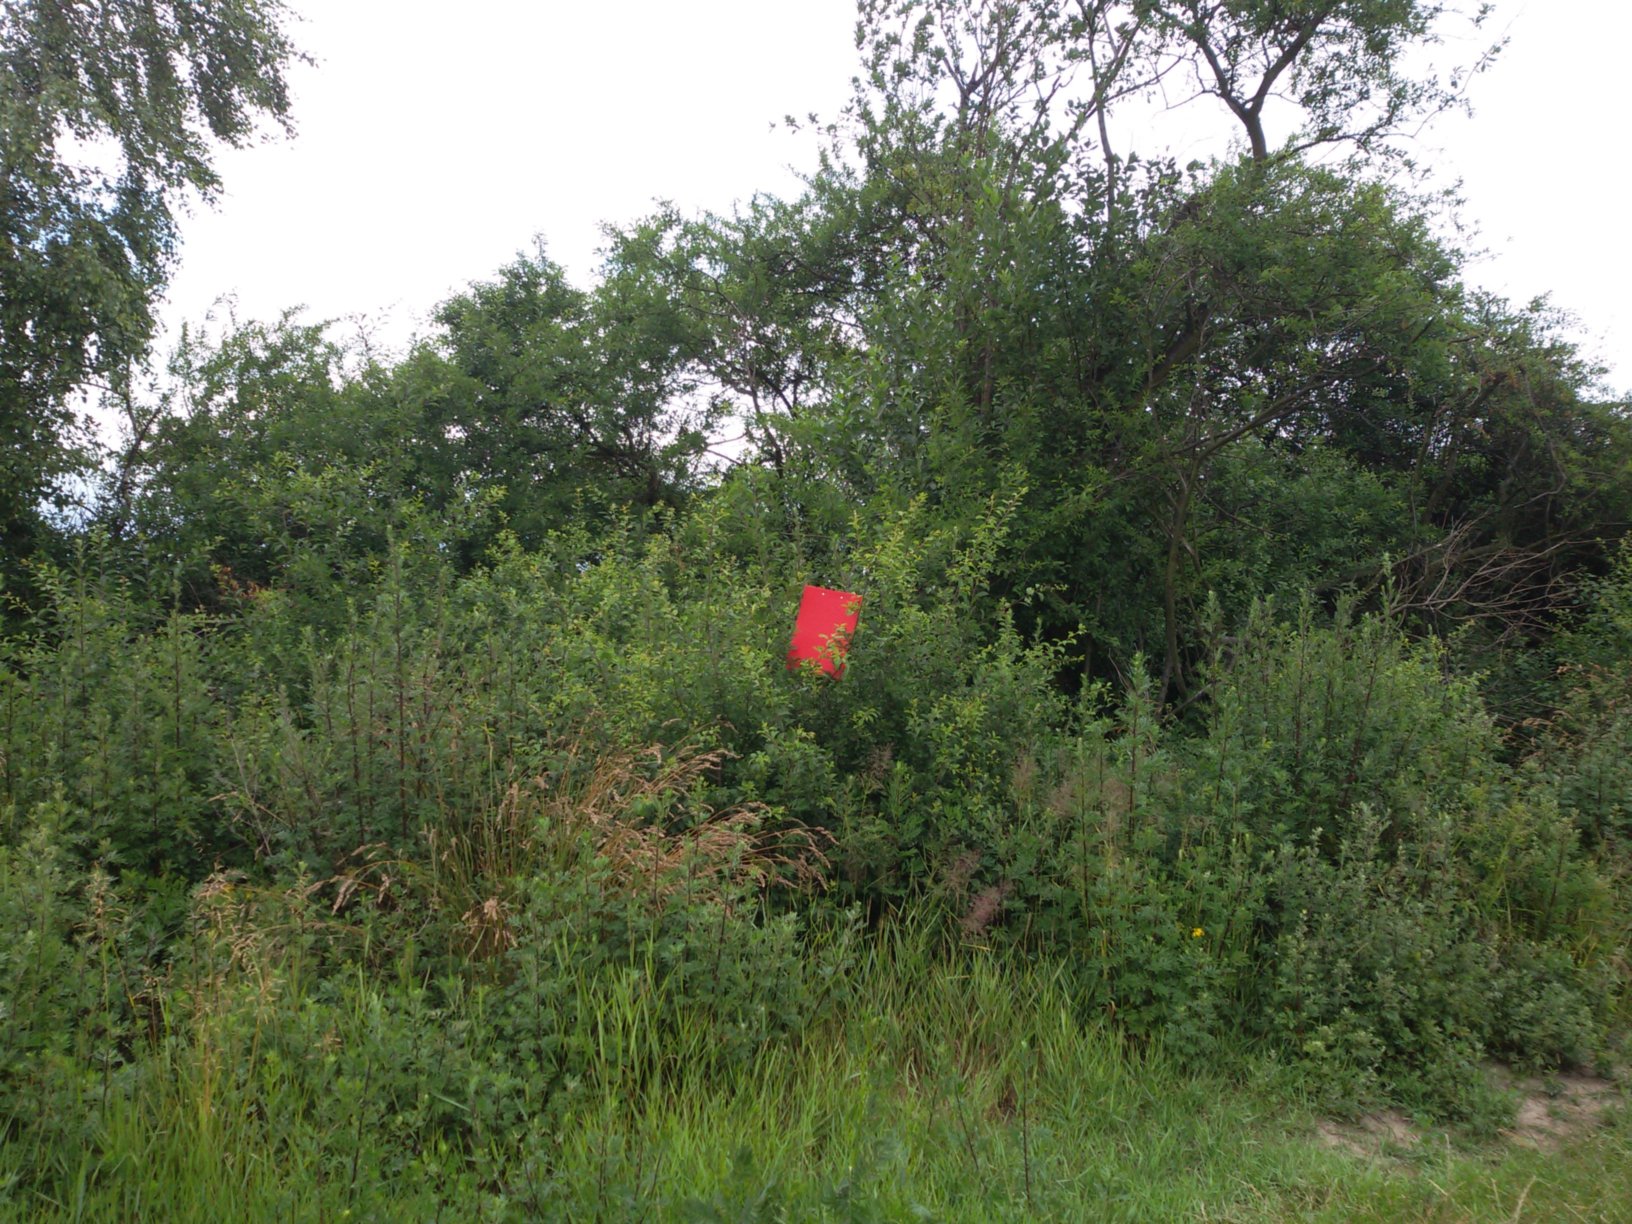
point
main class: Shrubland
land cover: Shrubland with sparse tree cover
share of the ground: > 75 %
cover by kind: shrubs 95 %, broadleaved forest trees 5 %
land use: Semi-natural and natural areas not in use
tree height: < 5 m
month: June
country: PL
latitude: 50.7314
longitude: 17.2226
